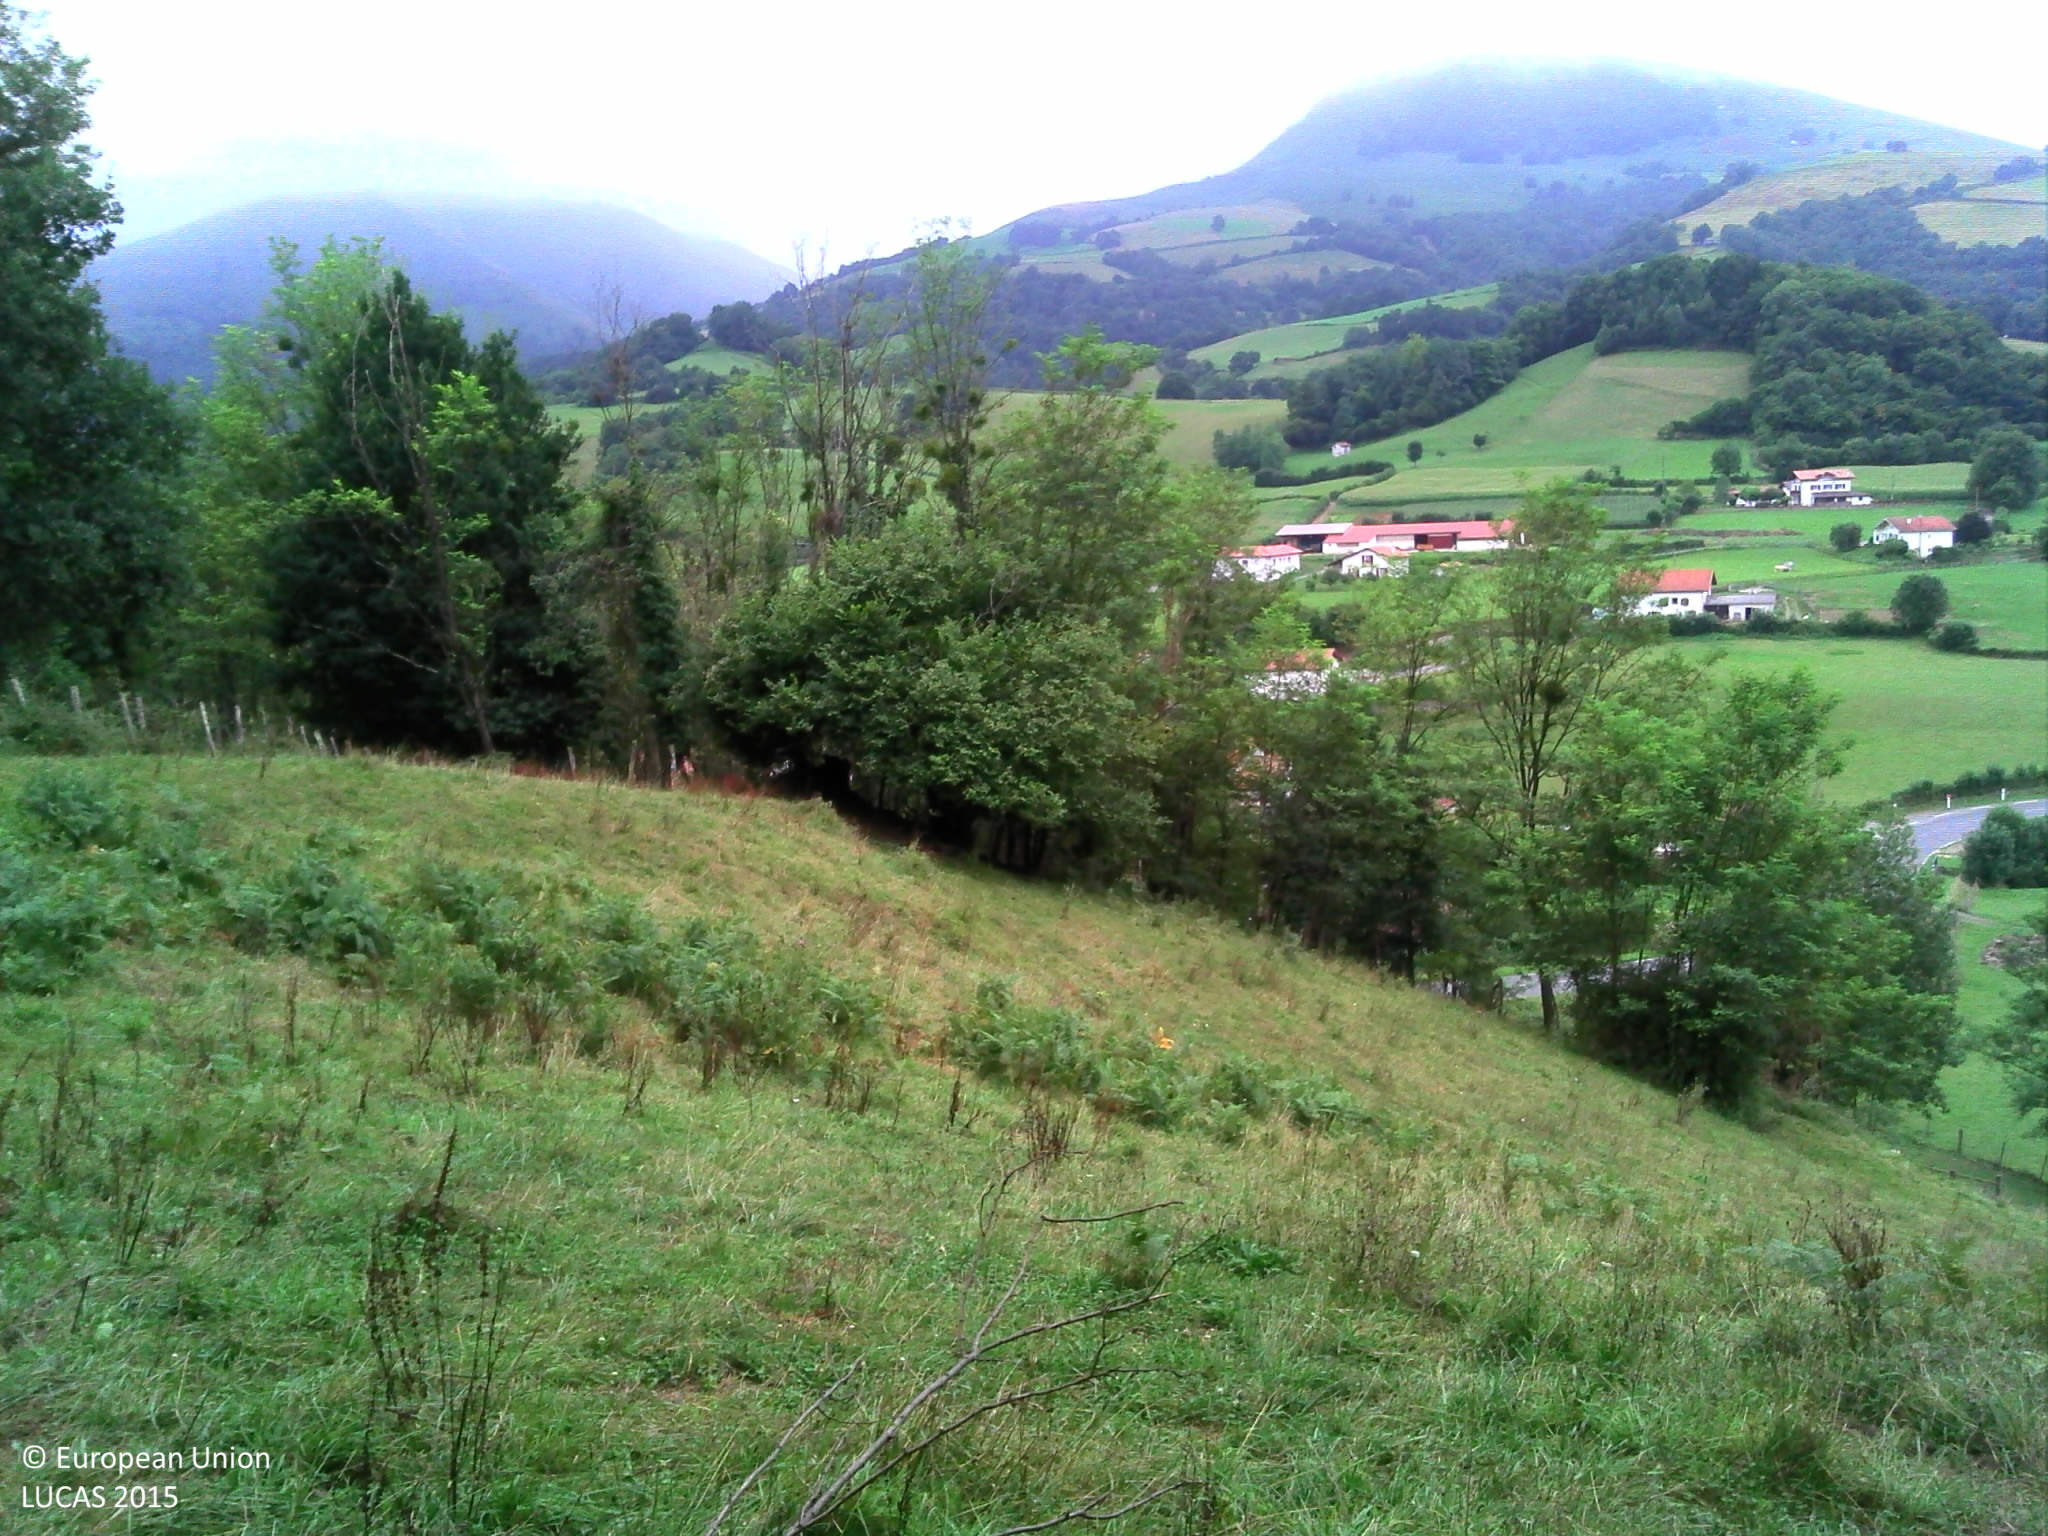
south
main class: Woodland
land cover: Broadleaved woodland
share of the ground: > 75 %
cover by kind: broadleaved forest trees 50 %, herbaceous plants 35 %, shrubs 15 %
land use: Forestry
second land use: Agriculture (excluding fallow land and kitchen gardens)
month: August
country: FR
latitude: 43.1828
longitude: -1.3210
